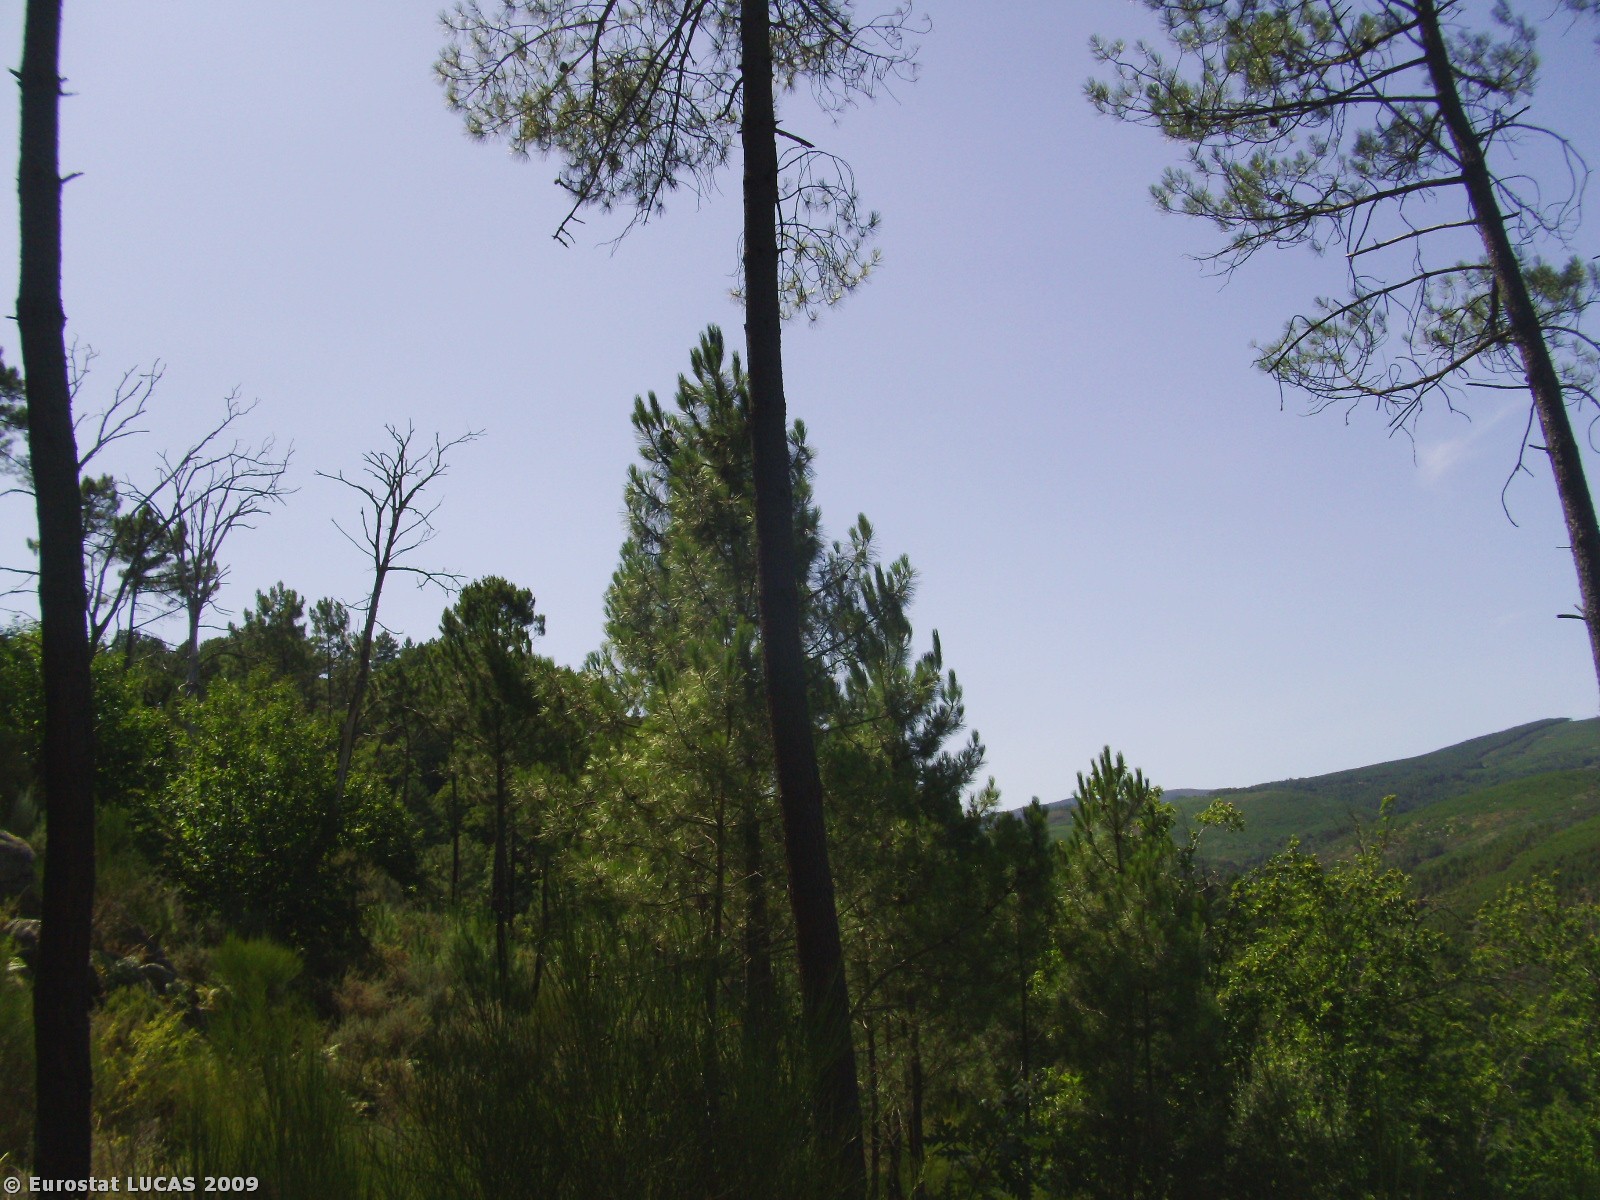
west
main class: Shrubland
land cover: Shrubland with sparse tree cover
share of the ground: > 75 %
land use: Forestry
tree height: > 5 m
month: August
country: PT
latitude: 41.6512
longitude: -7.6031
